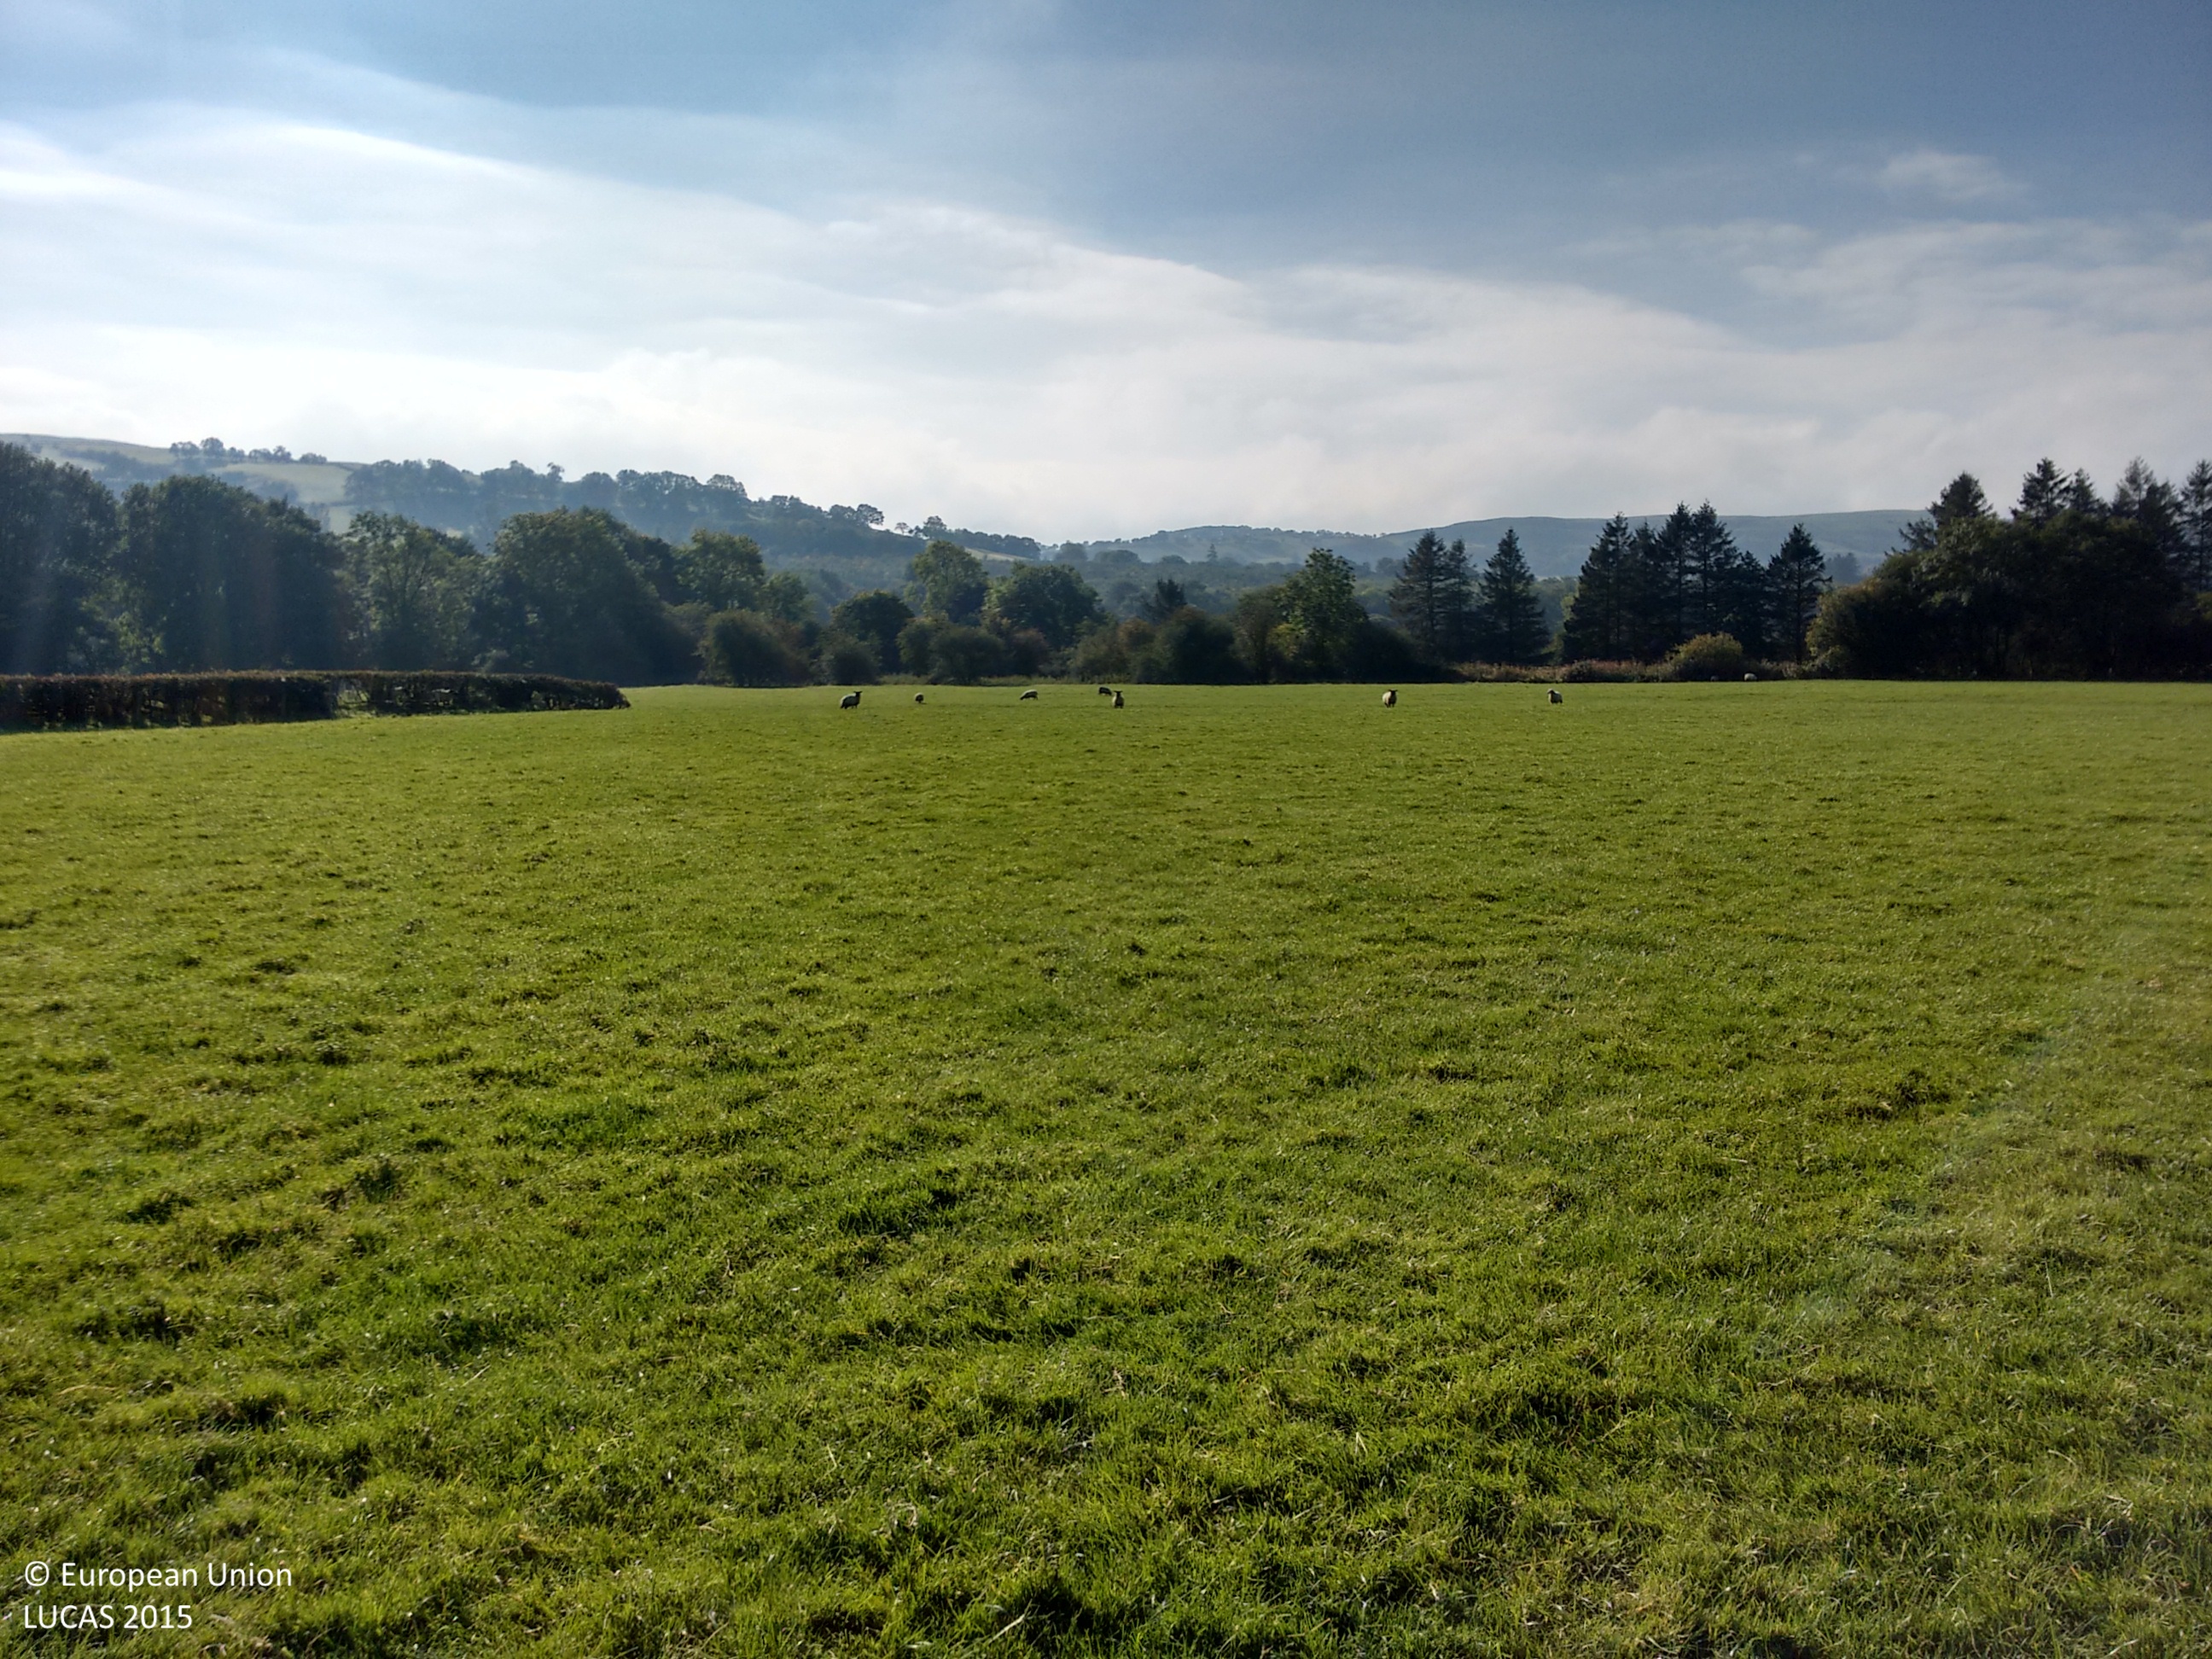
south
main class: Grassland
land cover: Grassland without tree/shrub cover
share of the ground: > 75 %
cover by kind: herbaceous plants 100 %
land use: Agriculture (excluding fallow land and kitchen gardens)
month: October
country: GB
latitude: 52.6878
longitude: -3.4120
